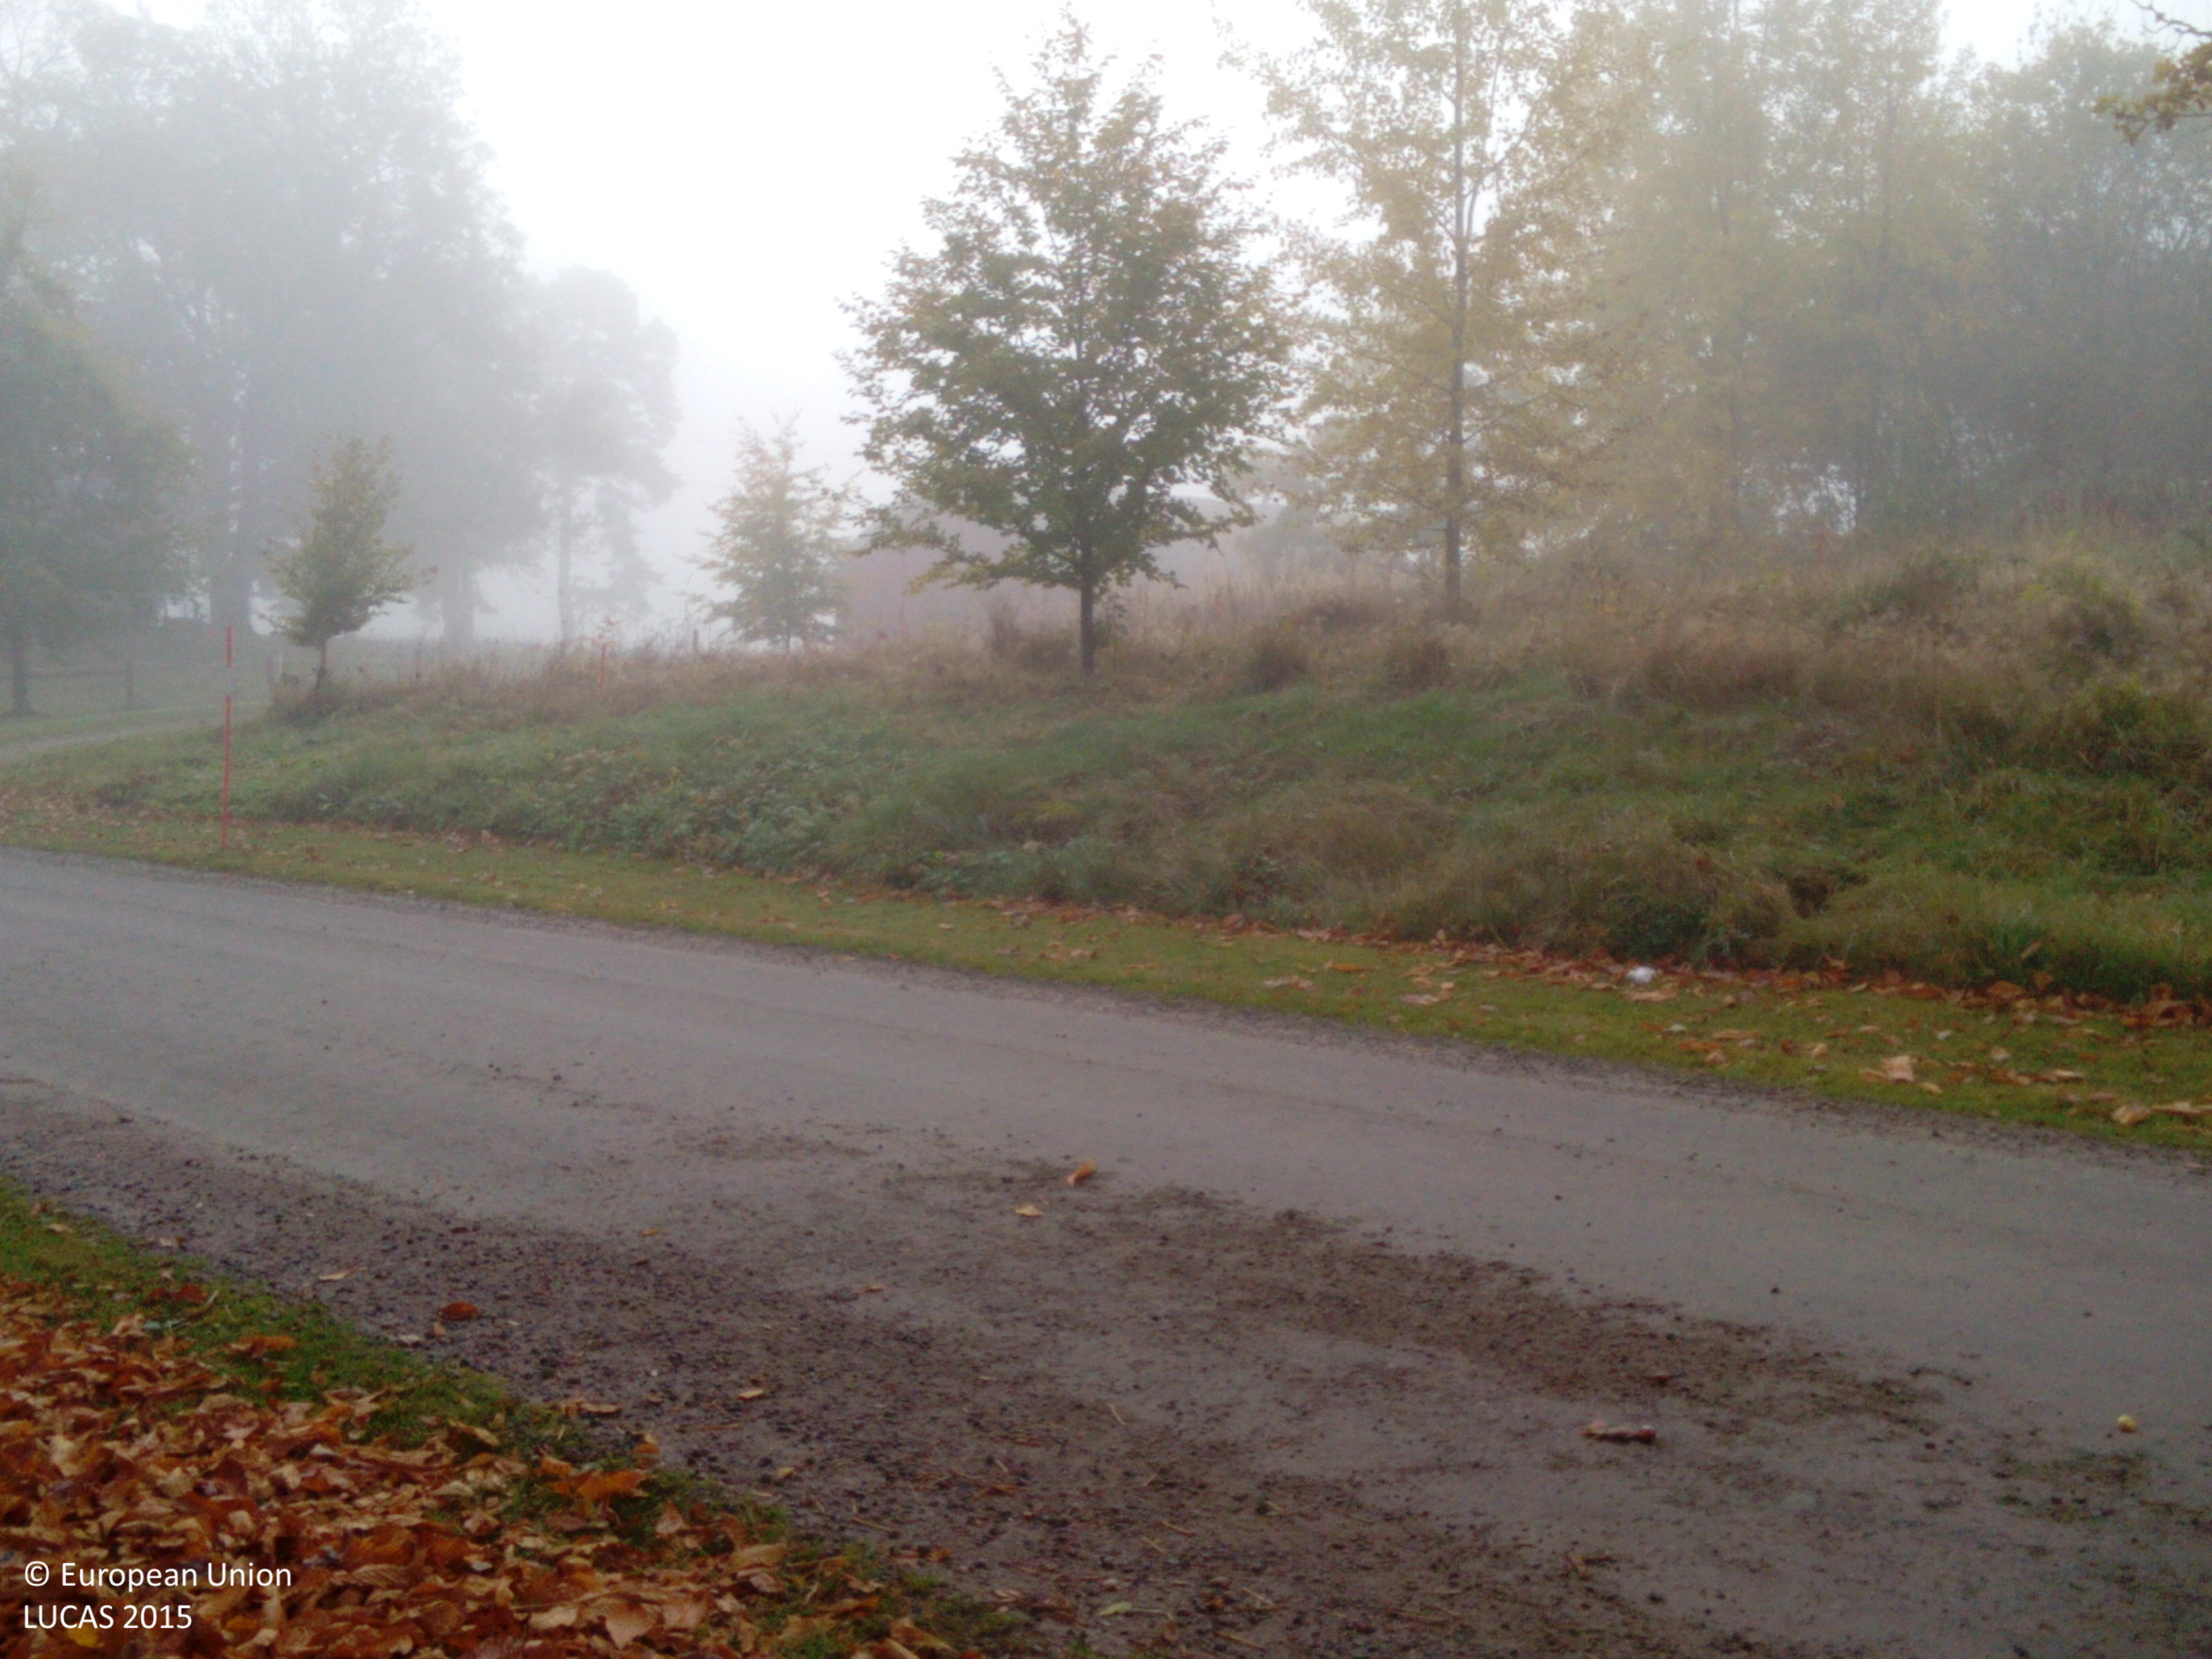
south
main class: Grassland
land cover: Grassland with sparse tree/shrub cover
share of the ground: > 75 %
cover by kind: herbaceous plants 70 %, consolidated bare surface 15 %, broadleaved forest trees 5 %
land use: Residential
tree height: > 5 m
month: October
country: SE
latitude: 58.9659
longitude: 16.4810
